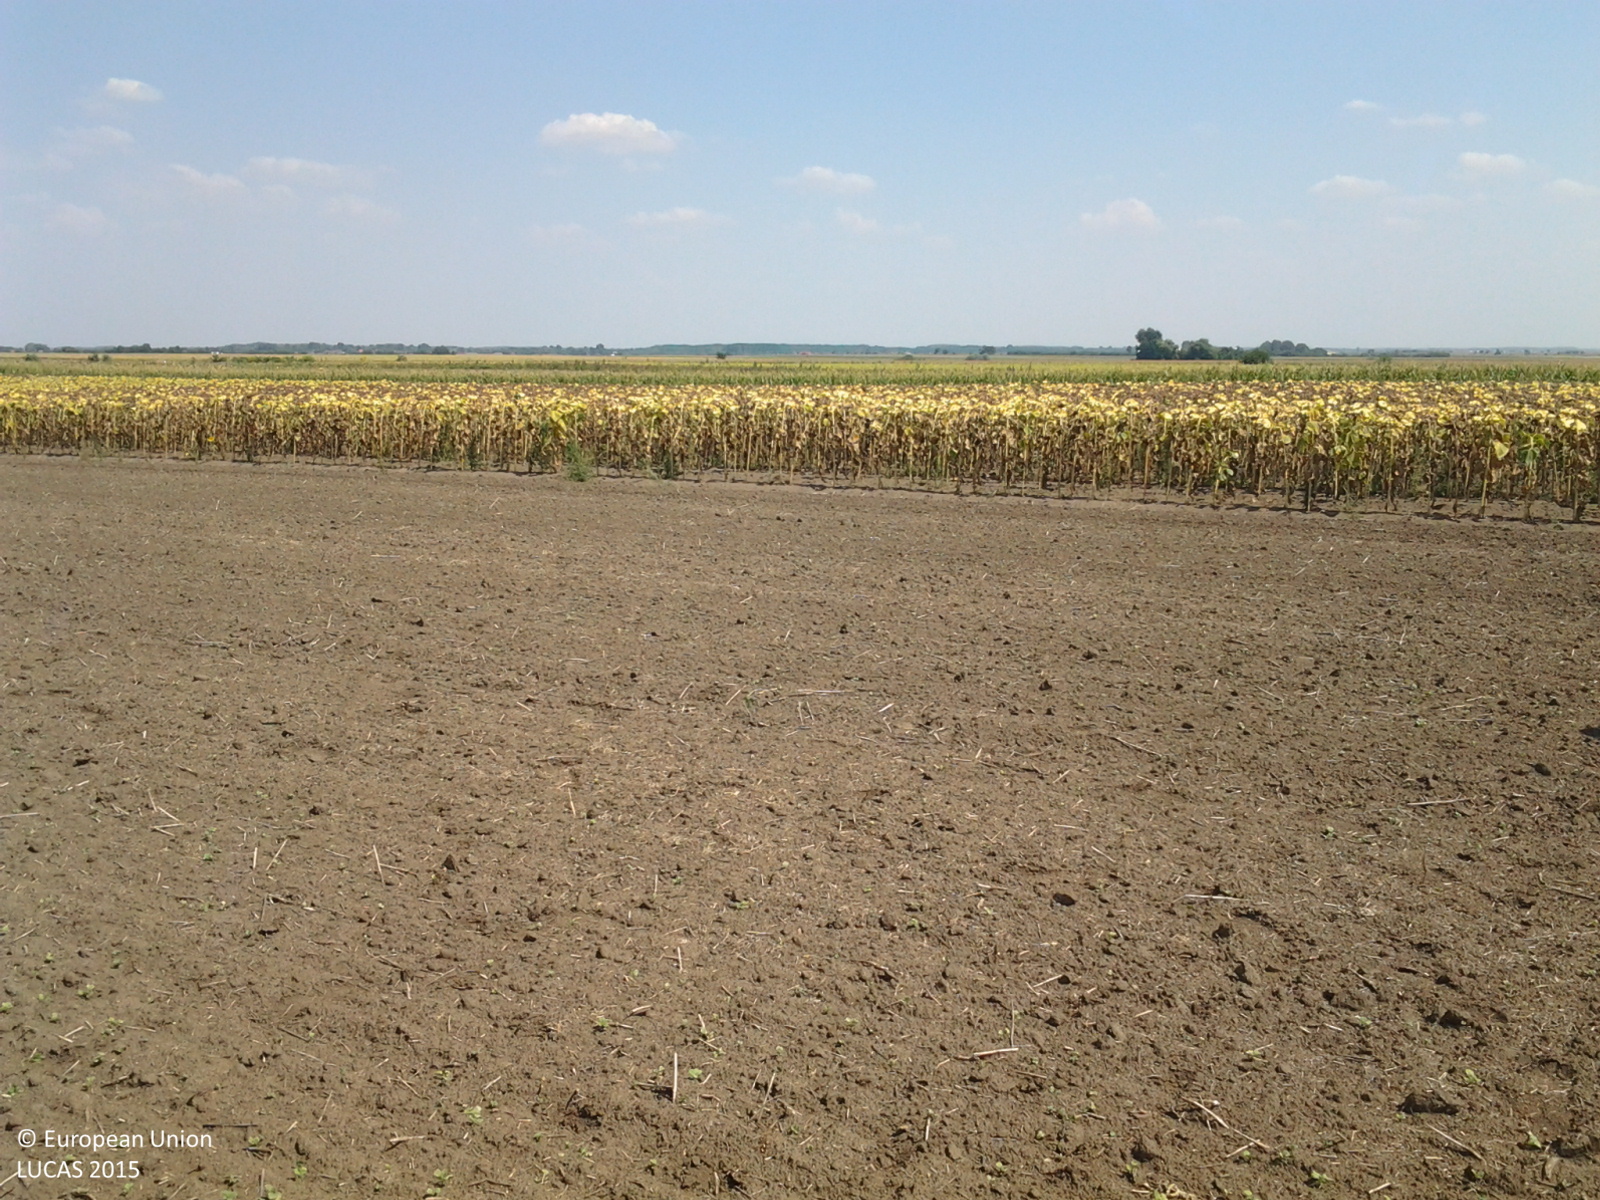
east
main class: Cropland
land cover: Rape and turnip rape
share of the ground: < 10 %
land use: Agriculture (excluding fallow land and kitchen gardens)
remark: Harvested field
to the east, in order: Rape and turnip rape; Sunflower; Maize; Sunflower; Rape and turnip rape; Sunflower
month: August
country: HU
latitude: 47.3218
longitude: 19.7207
